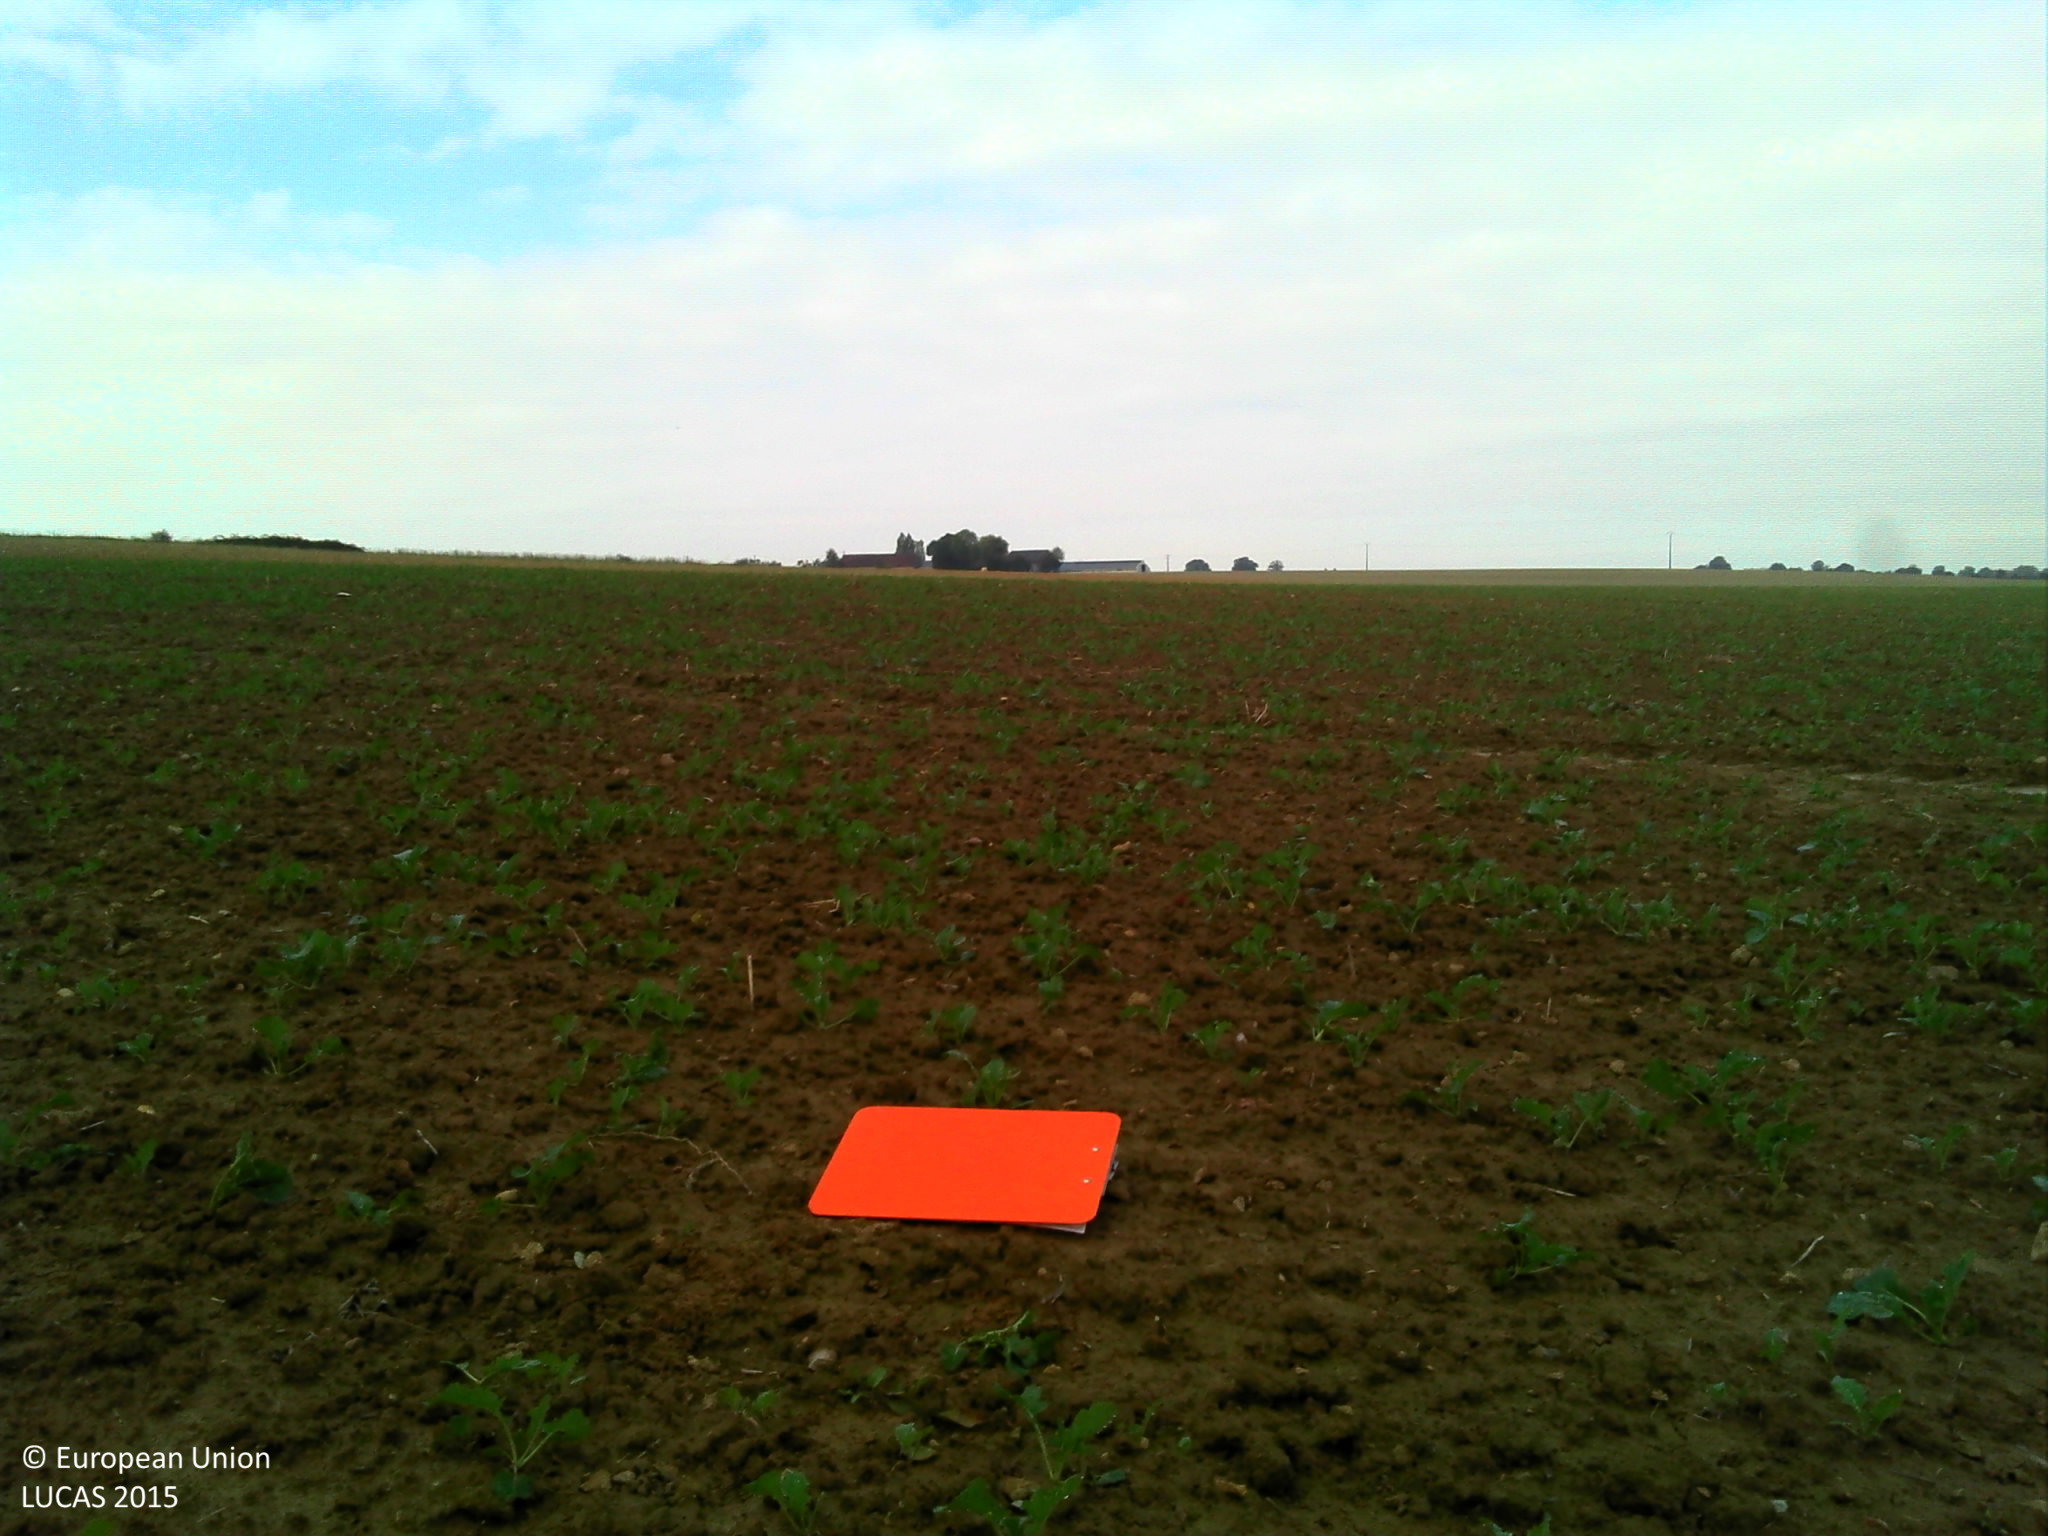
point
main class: Cropland
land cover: Rape and turnip rape
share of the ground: 50 - 75 %
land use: Agriculture (excluding fallow land and kitchen gardens)
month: October
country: FR
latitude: 48.1144
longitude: 1.0755
